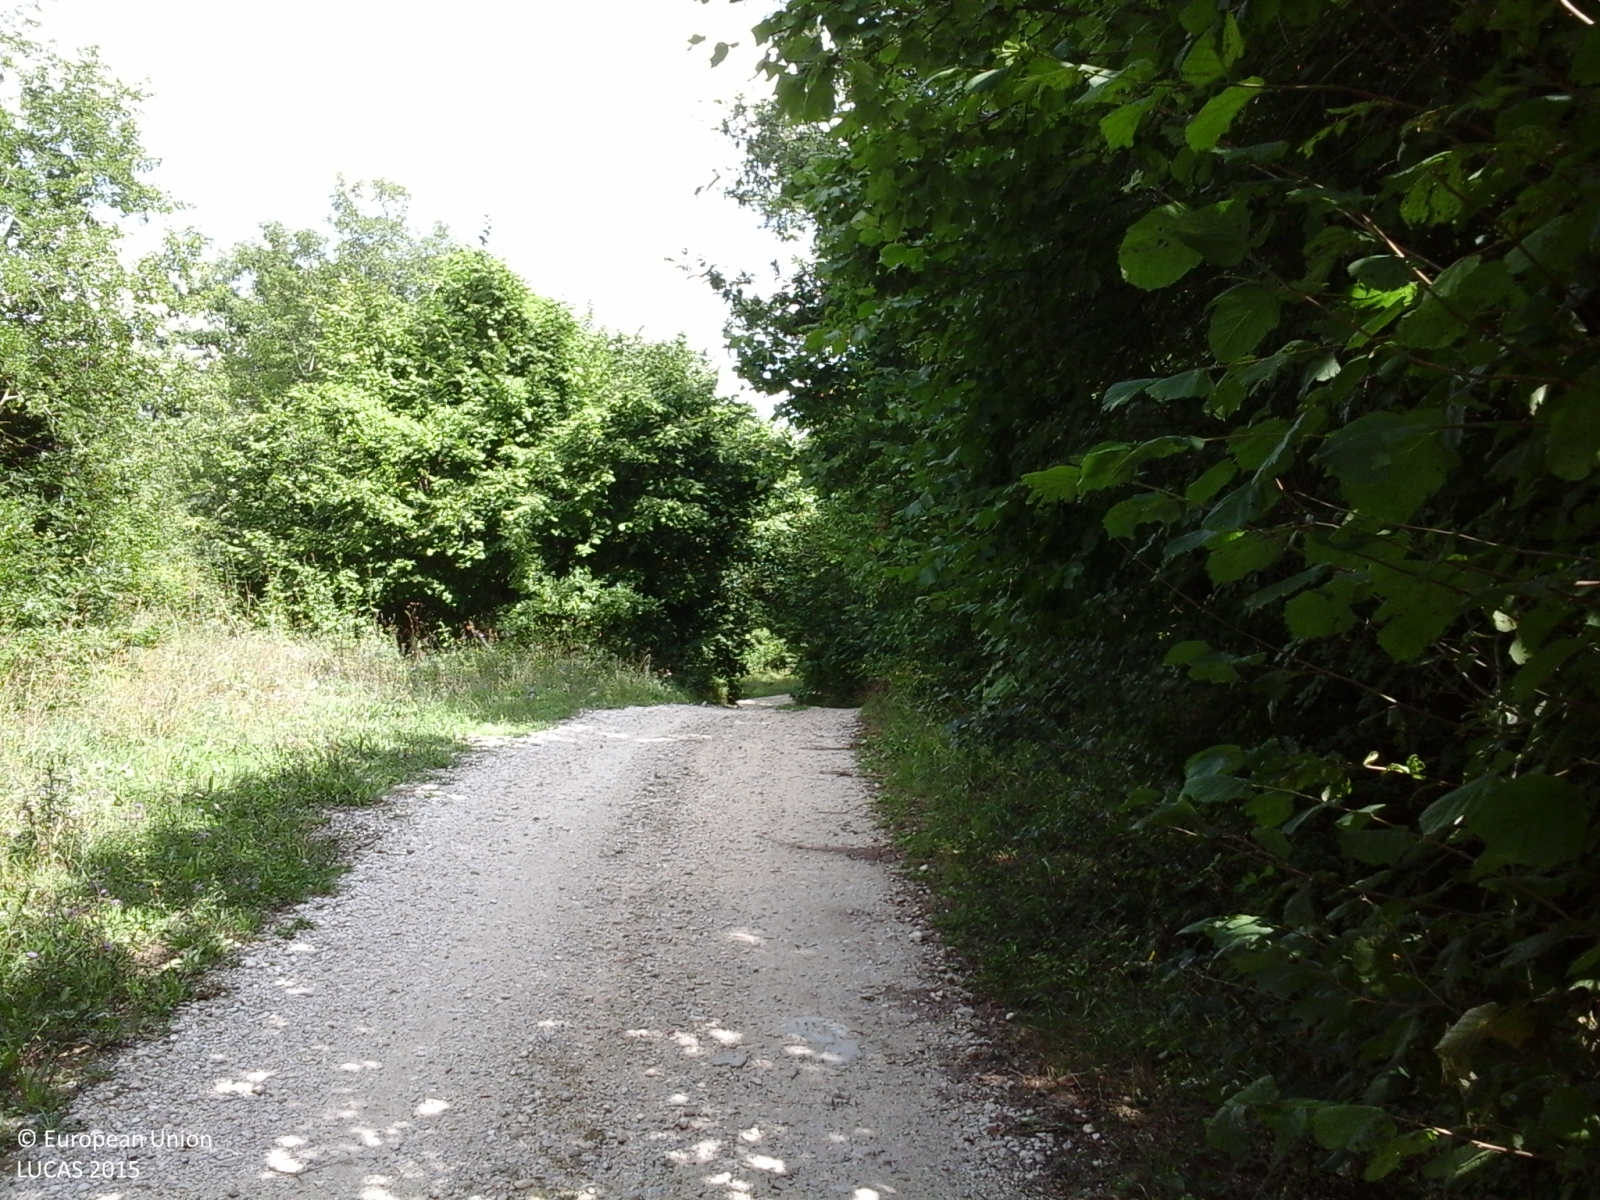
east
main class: Woodland
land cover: Broadleaved woodland
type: thermophilous deciduous forest
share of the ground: > 75 %
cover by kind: broadleaved forest trees 95 %, shrubs 5 %
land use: Forestry
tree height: > 5 m
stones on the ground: < 10 %
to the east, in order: Broadleaved woodland; Tracks; Broadleaved woodland; Grassland without tree/shrub cover; Abandoned hedges; Grassland without tree/shrub cover
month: August
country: IT
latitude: 41.7356
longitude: 14.1815
